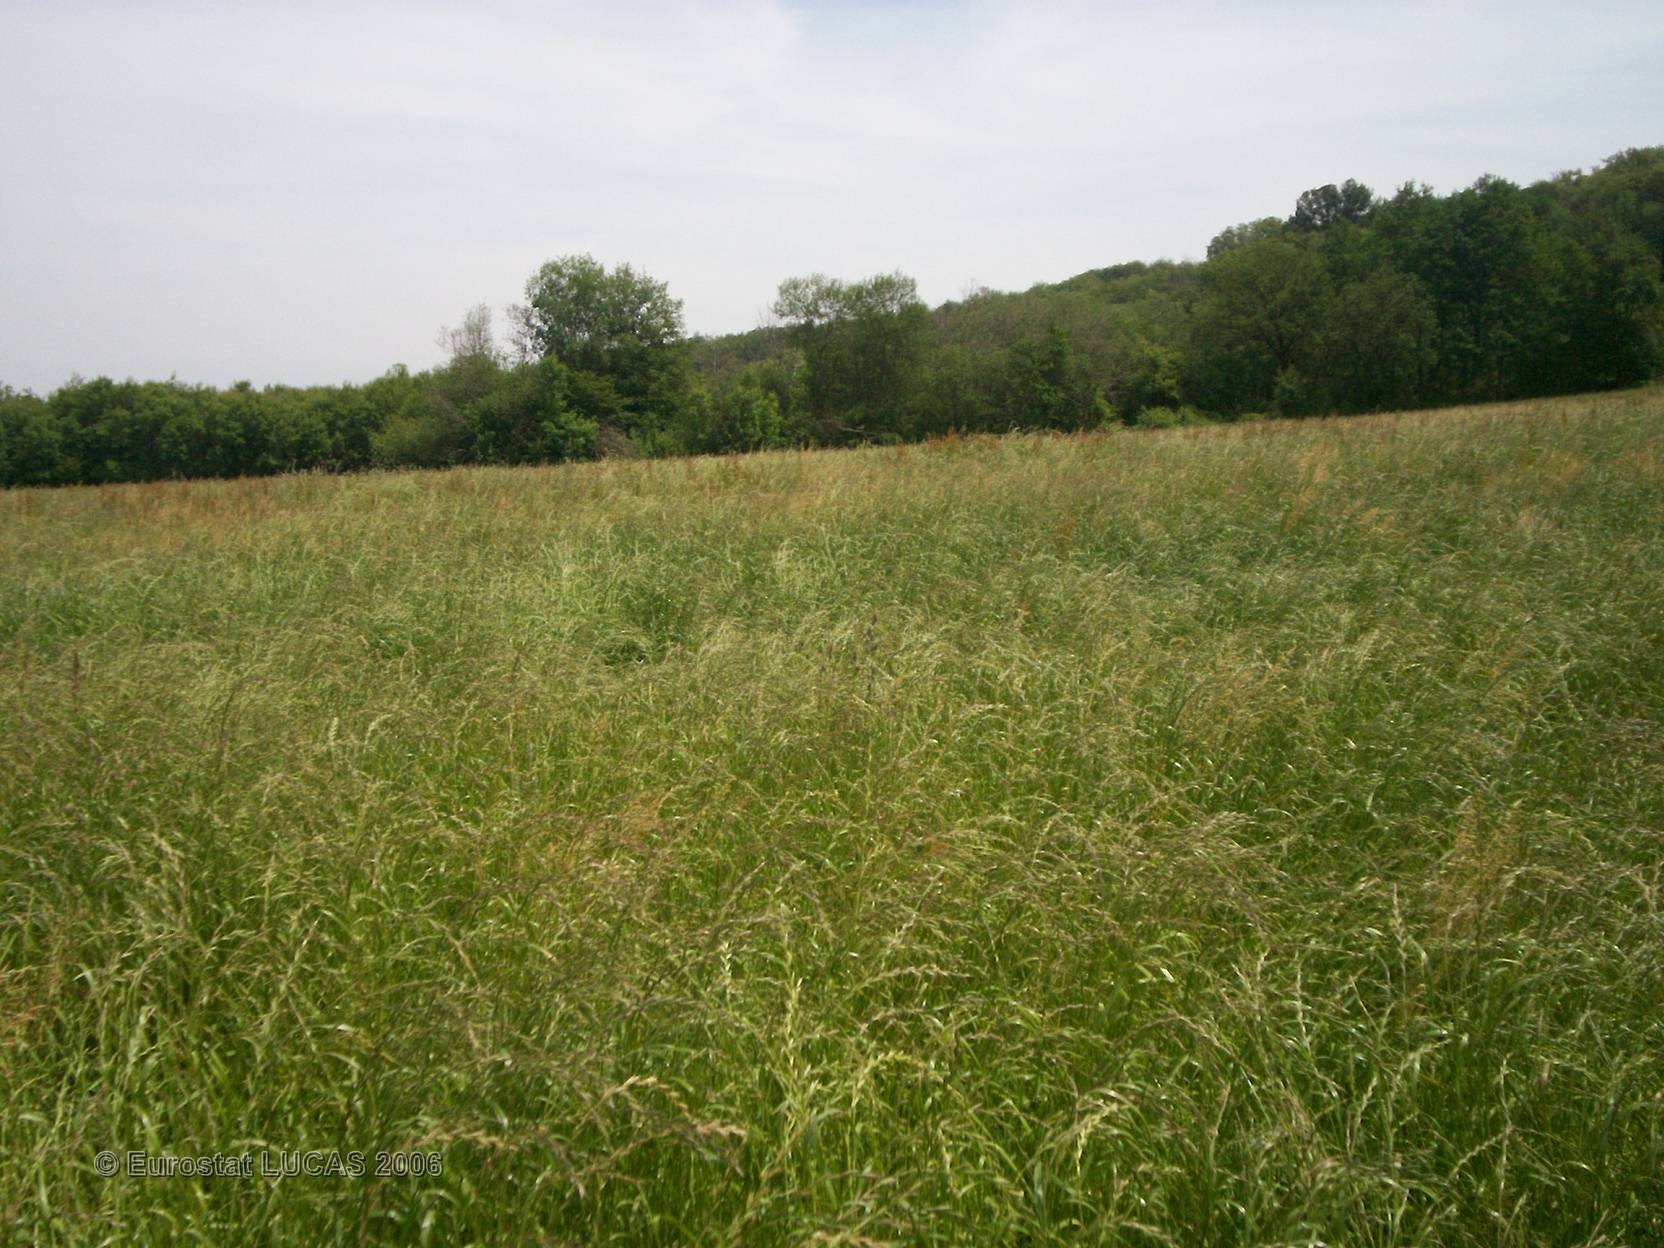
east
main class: Grassland
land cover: Grassland without tree/shrub cover
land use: Agriculture (excluding fallow land and kitchen gardens)
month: June
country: FR
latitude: 45.3025
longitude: 5.1460
